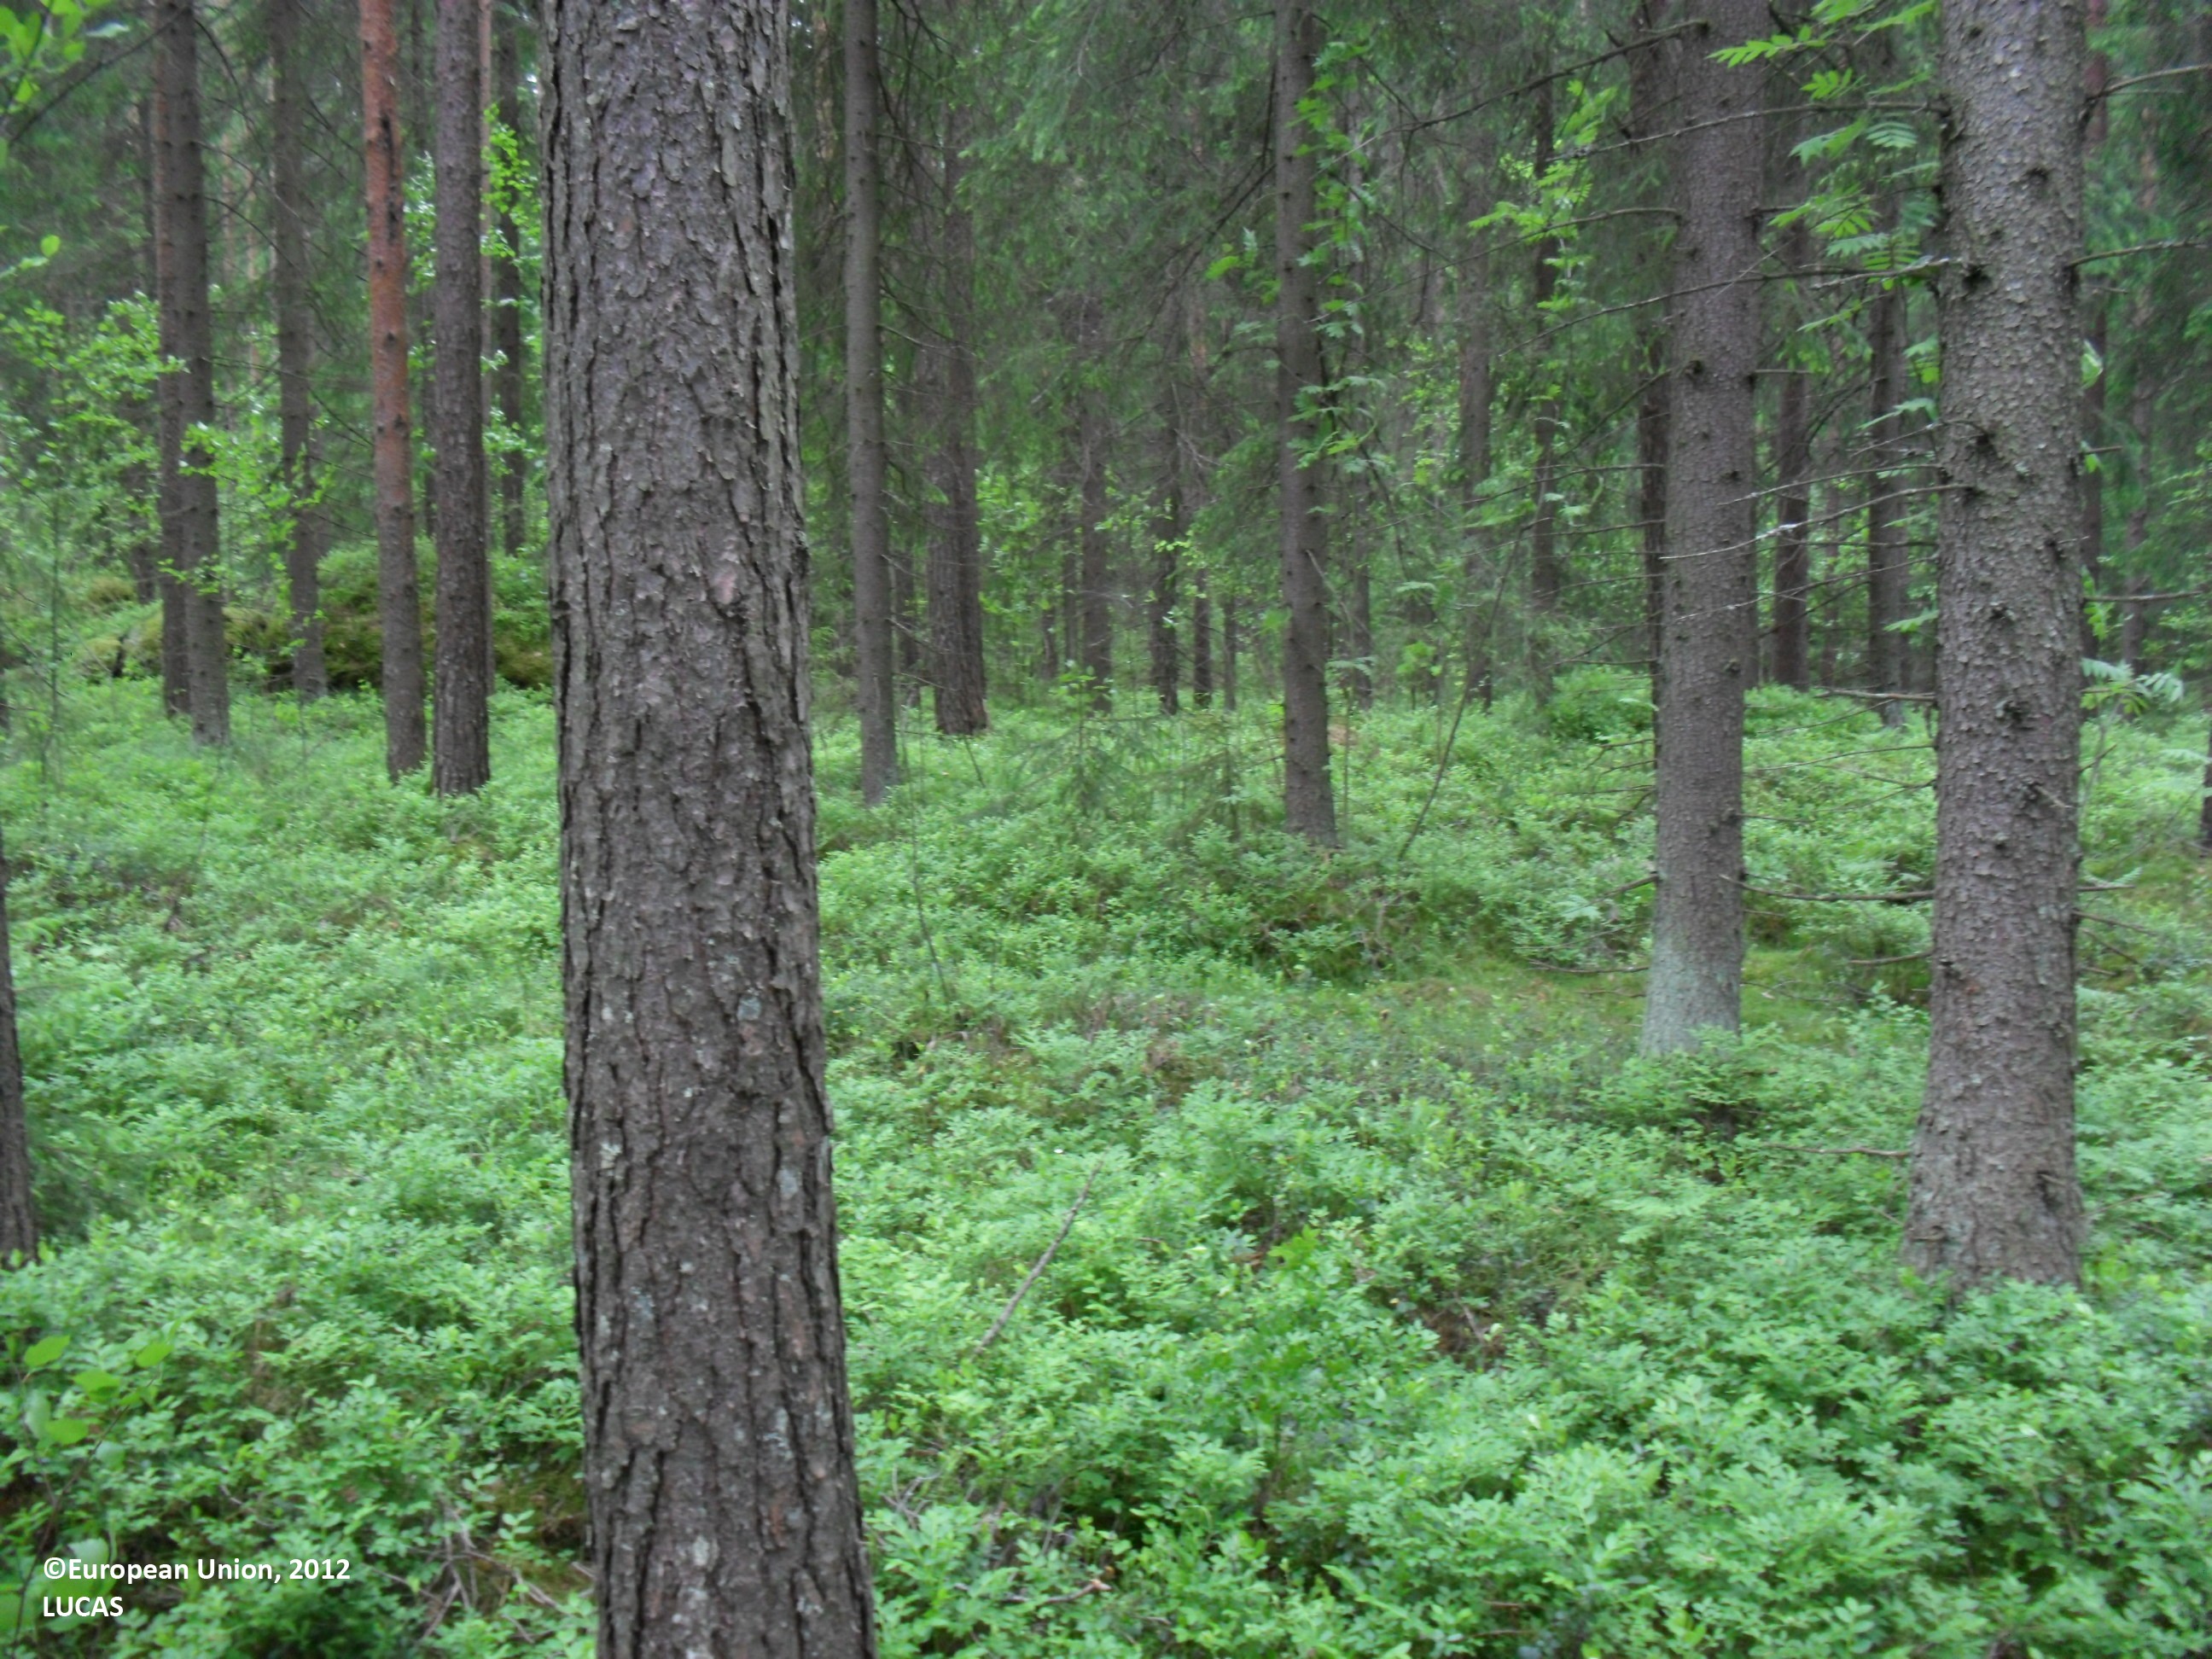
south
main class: Woodland
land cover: Spruce dominated coniferous woodland
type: boreal forest
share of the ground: 50 - 75 %
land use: Forestry
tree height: > 5 m
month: June
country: FI
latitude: 63.2292
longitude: 23.0924
